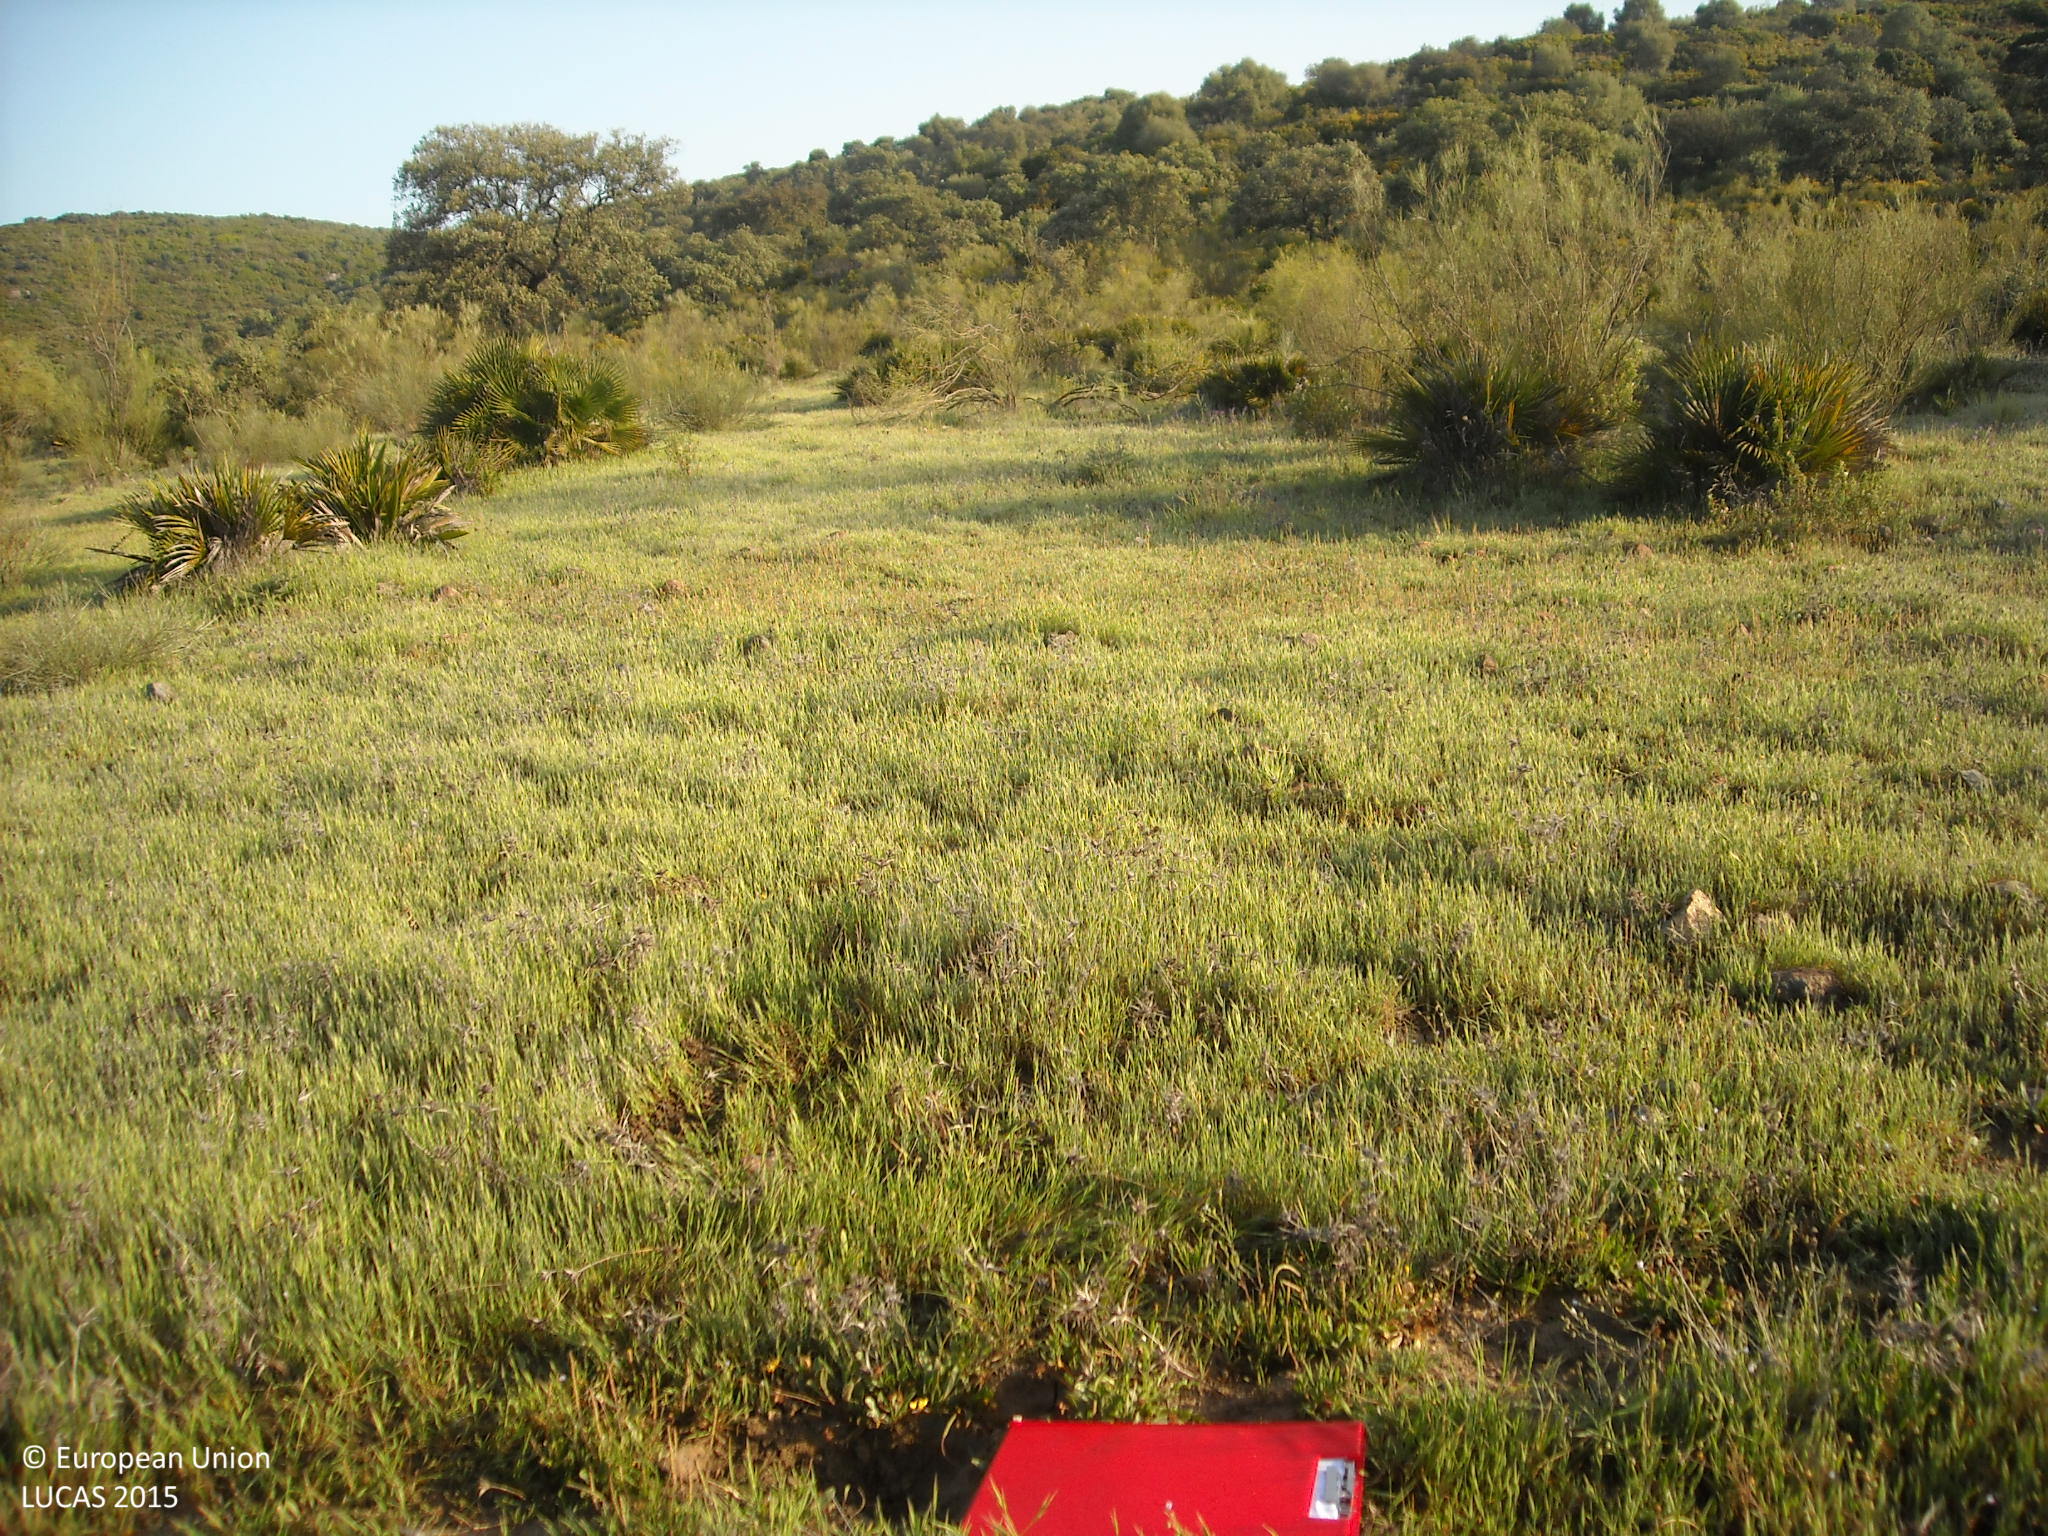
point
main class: Grassland
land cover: Grassland without tree/shrub cover
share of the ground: > 75 %
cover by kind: herbaceous plants 95 %, shrubs 5 %
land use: Agriculture (excluding fallow land and kitchen gardens)
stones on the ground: > 50 %
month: April
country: ES
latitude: 37.6275
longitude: -5.9473
